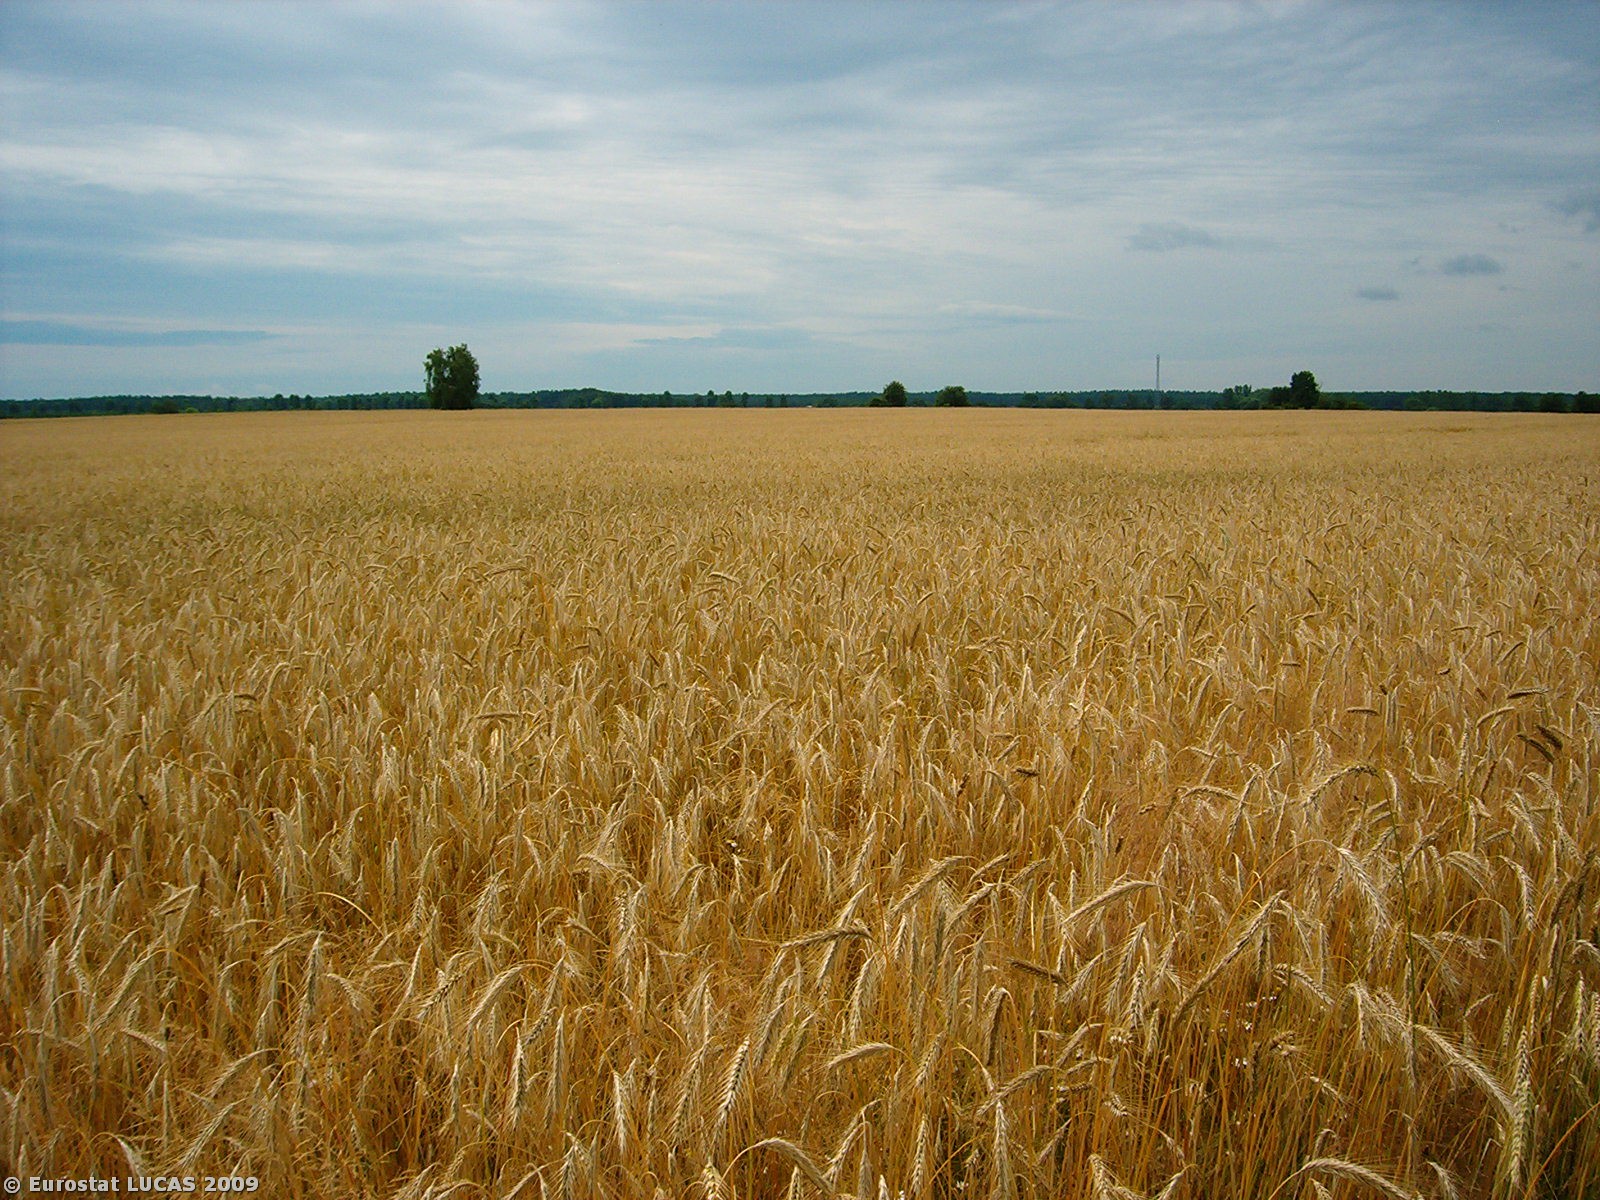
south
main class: Cropland
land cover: Triticale
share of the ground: > 75 %
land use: Agriculture (excluding fallow land and kitchen gardens)
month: July
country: PL
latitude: 52.3184
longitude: 15.1817
